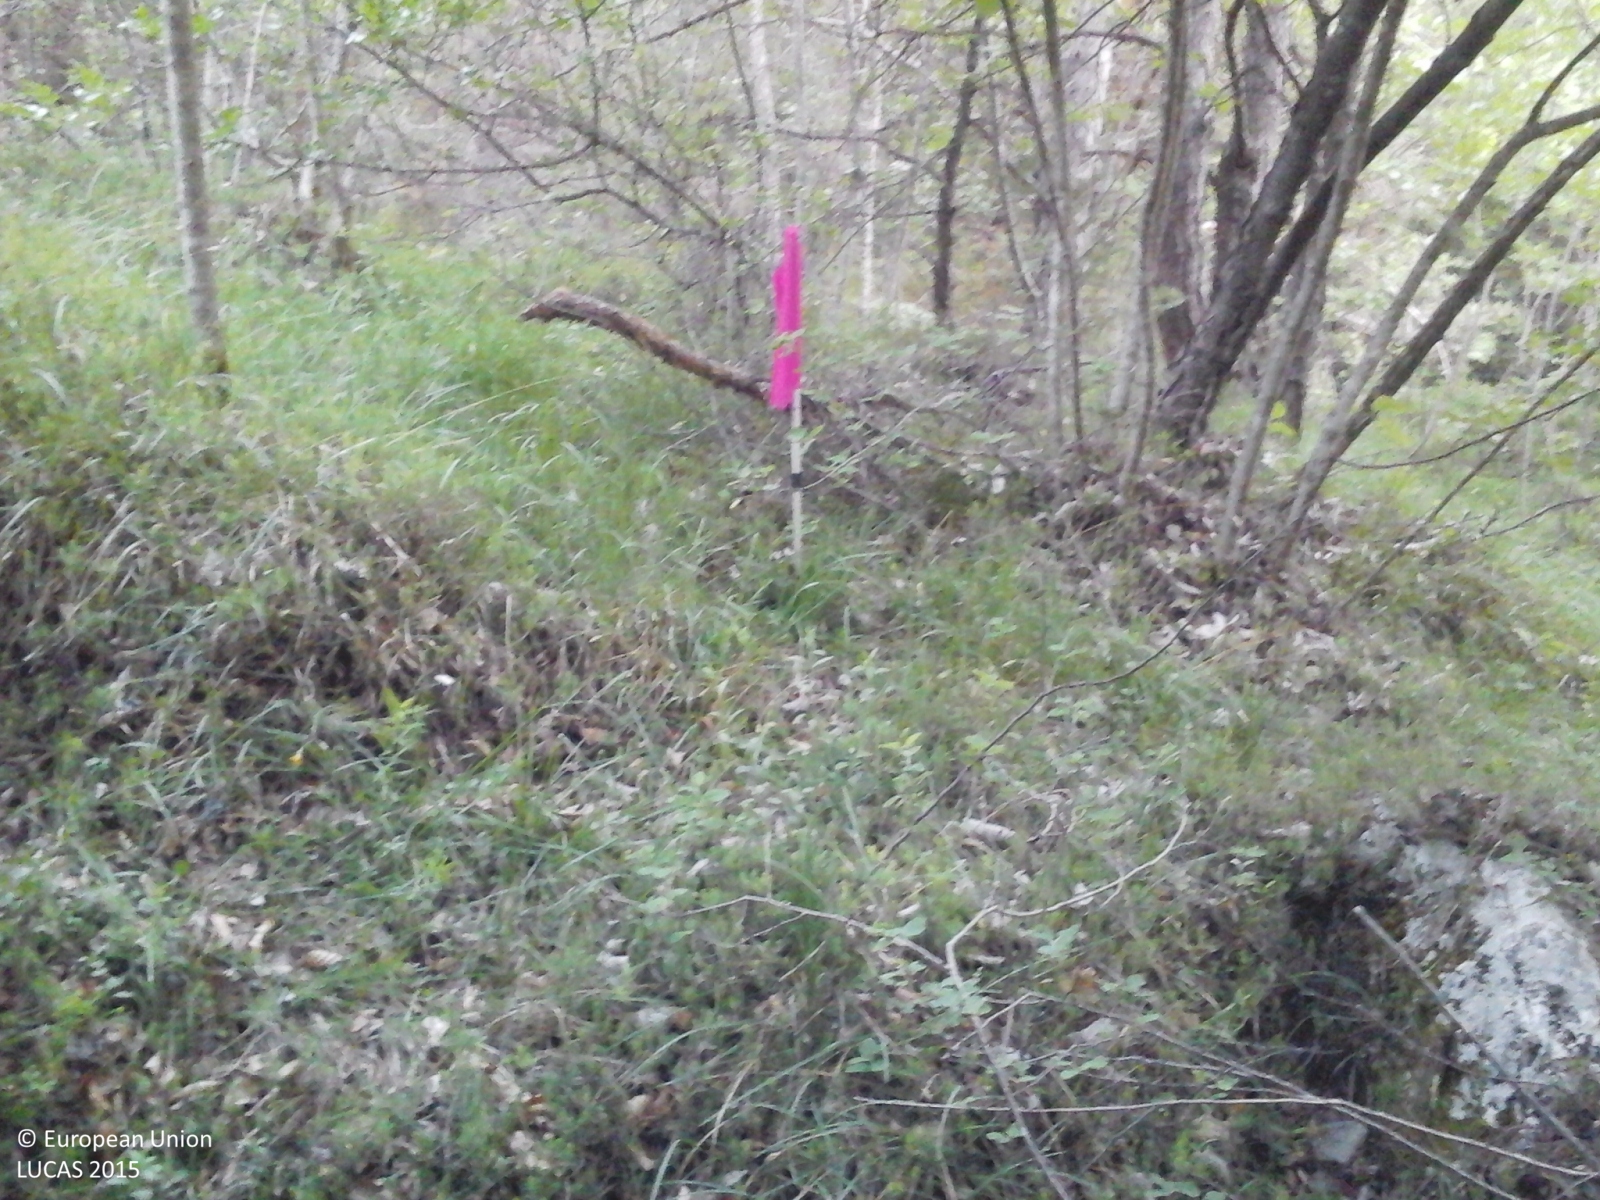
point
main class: Woodland
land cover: Broadleaved woodland
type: mountainous beech forest
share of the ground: > 75 %
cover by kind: broadleaved forest trees 100 %
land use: Forestry
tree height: > 5 m
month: June
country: IT
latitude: 45.9865
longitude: 10.9668
